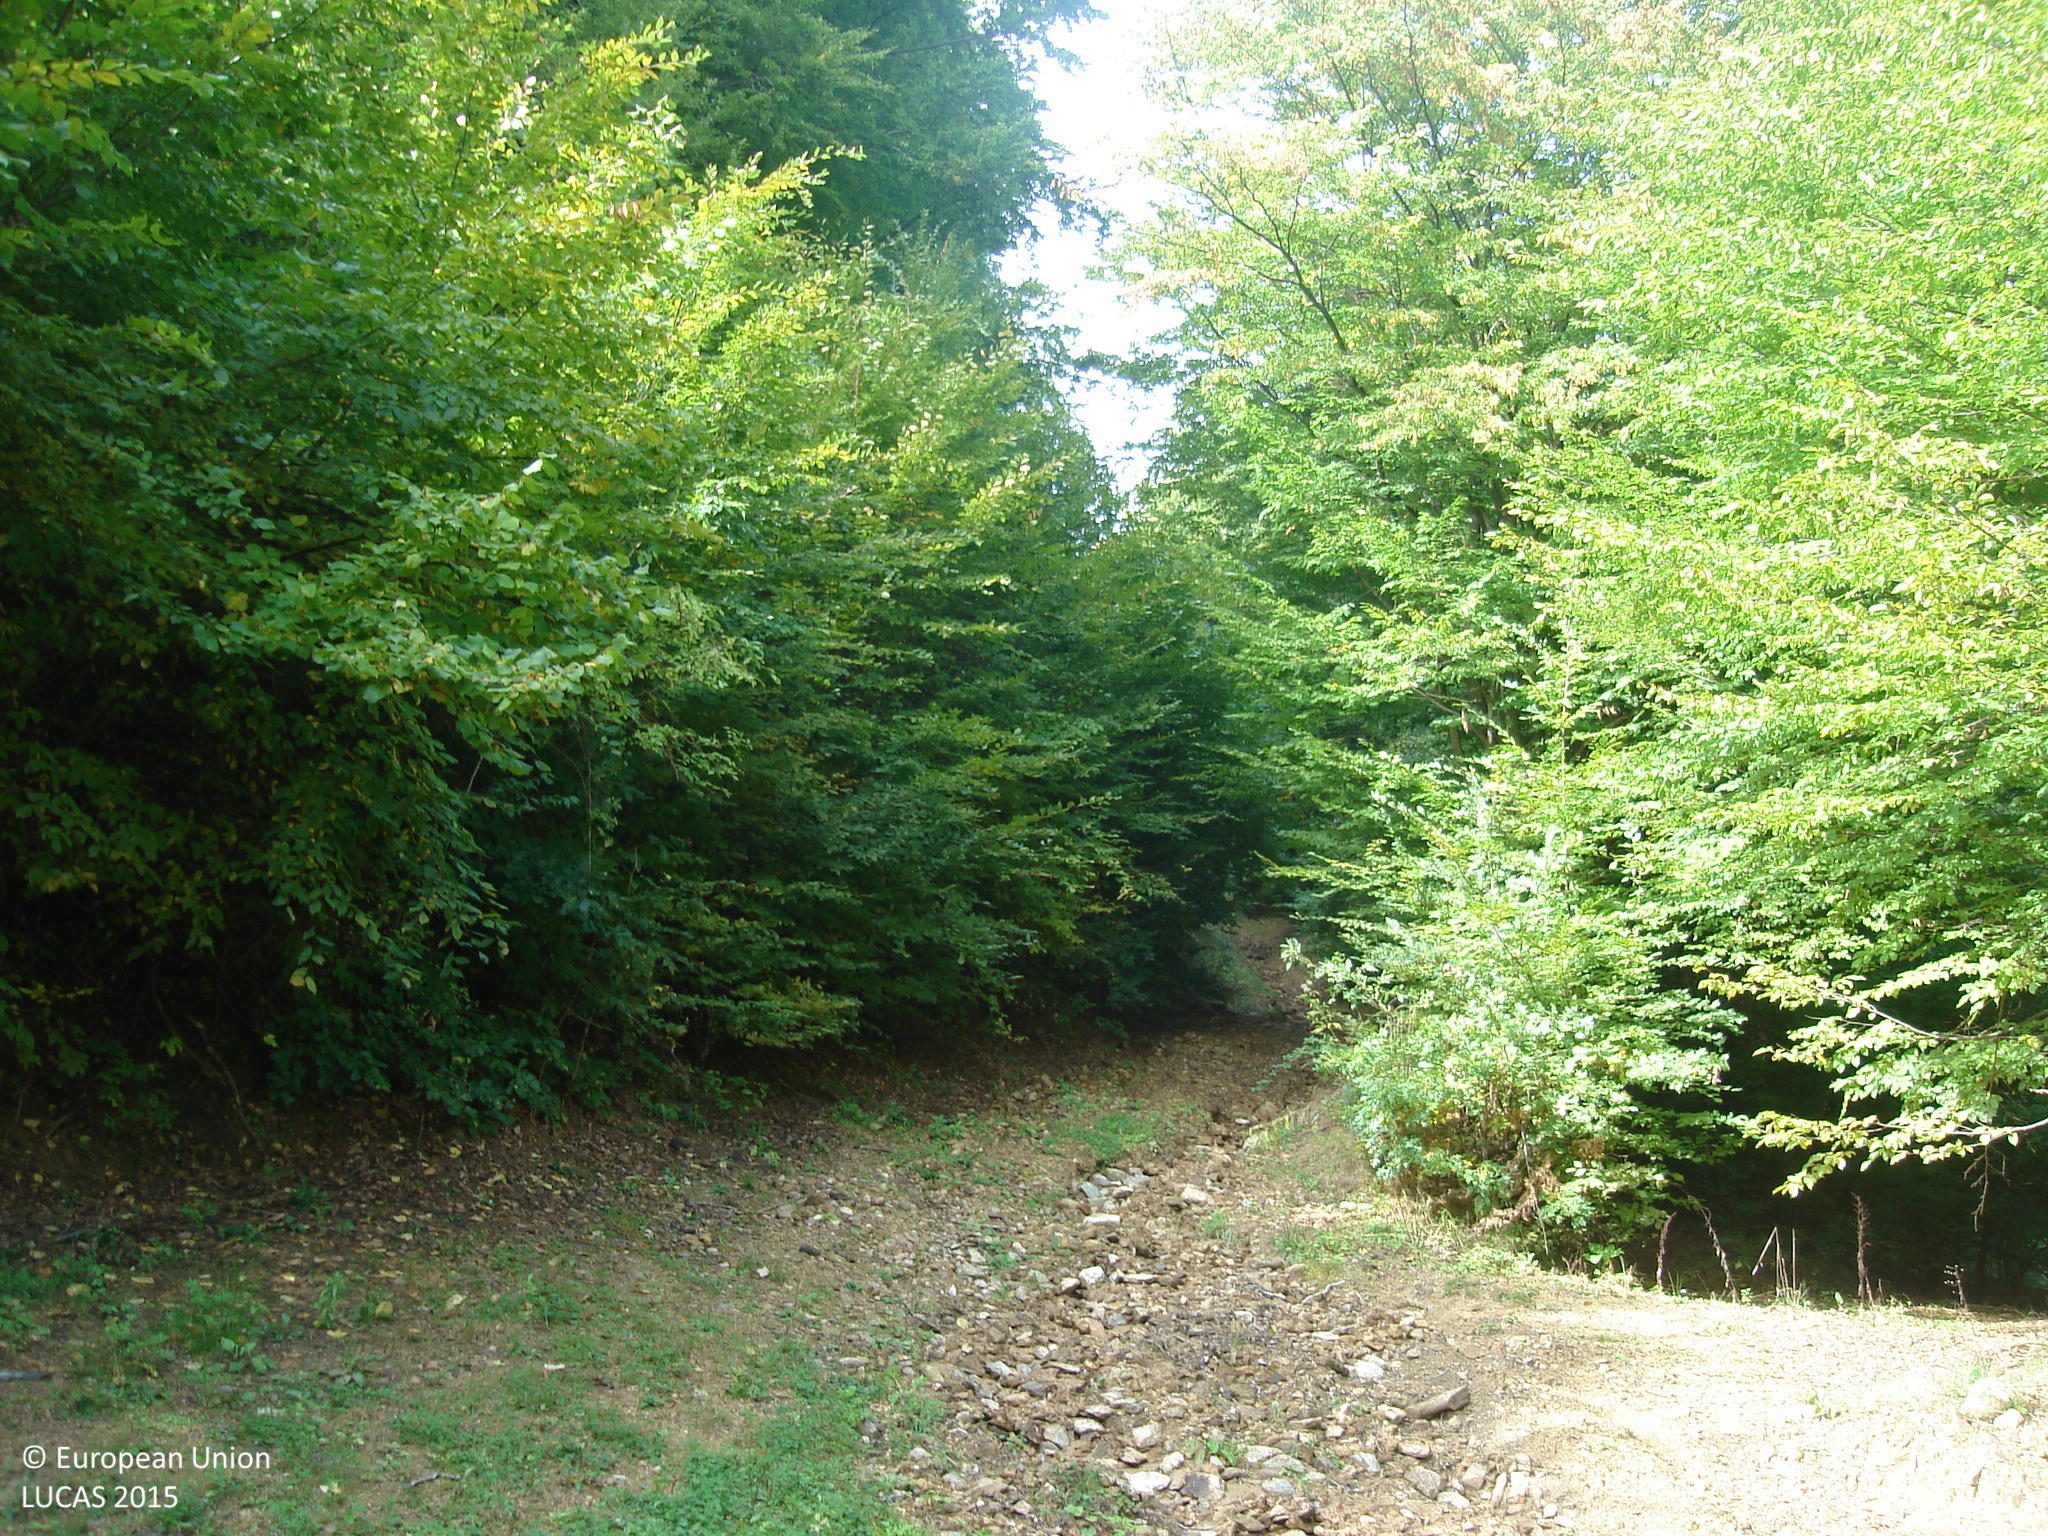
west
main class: Woodland
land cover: Broadleaved woodland
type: mesophytic deciduous forest
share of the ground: > 75 %
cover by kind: broadleaved forest trees 100 %
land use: Forestry
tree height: > 5 m
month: October
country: BG
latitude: 42.5795
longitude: 23.8207
